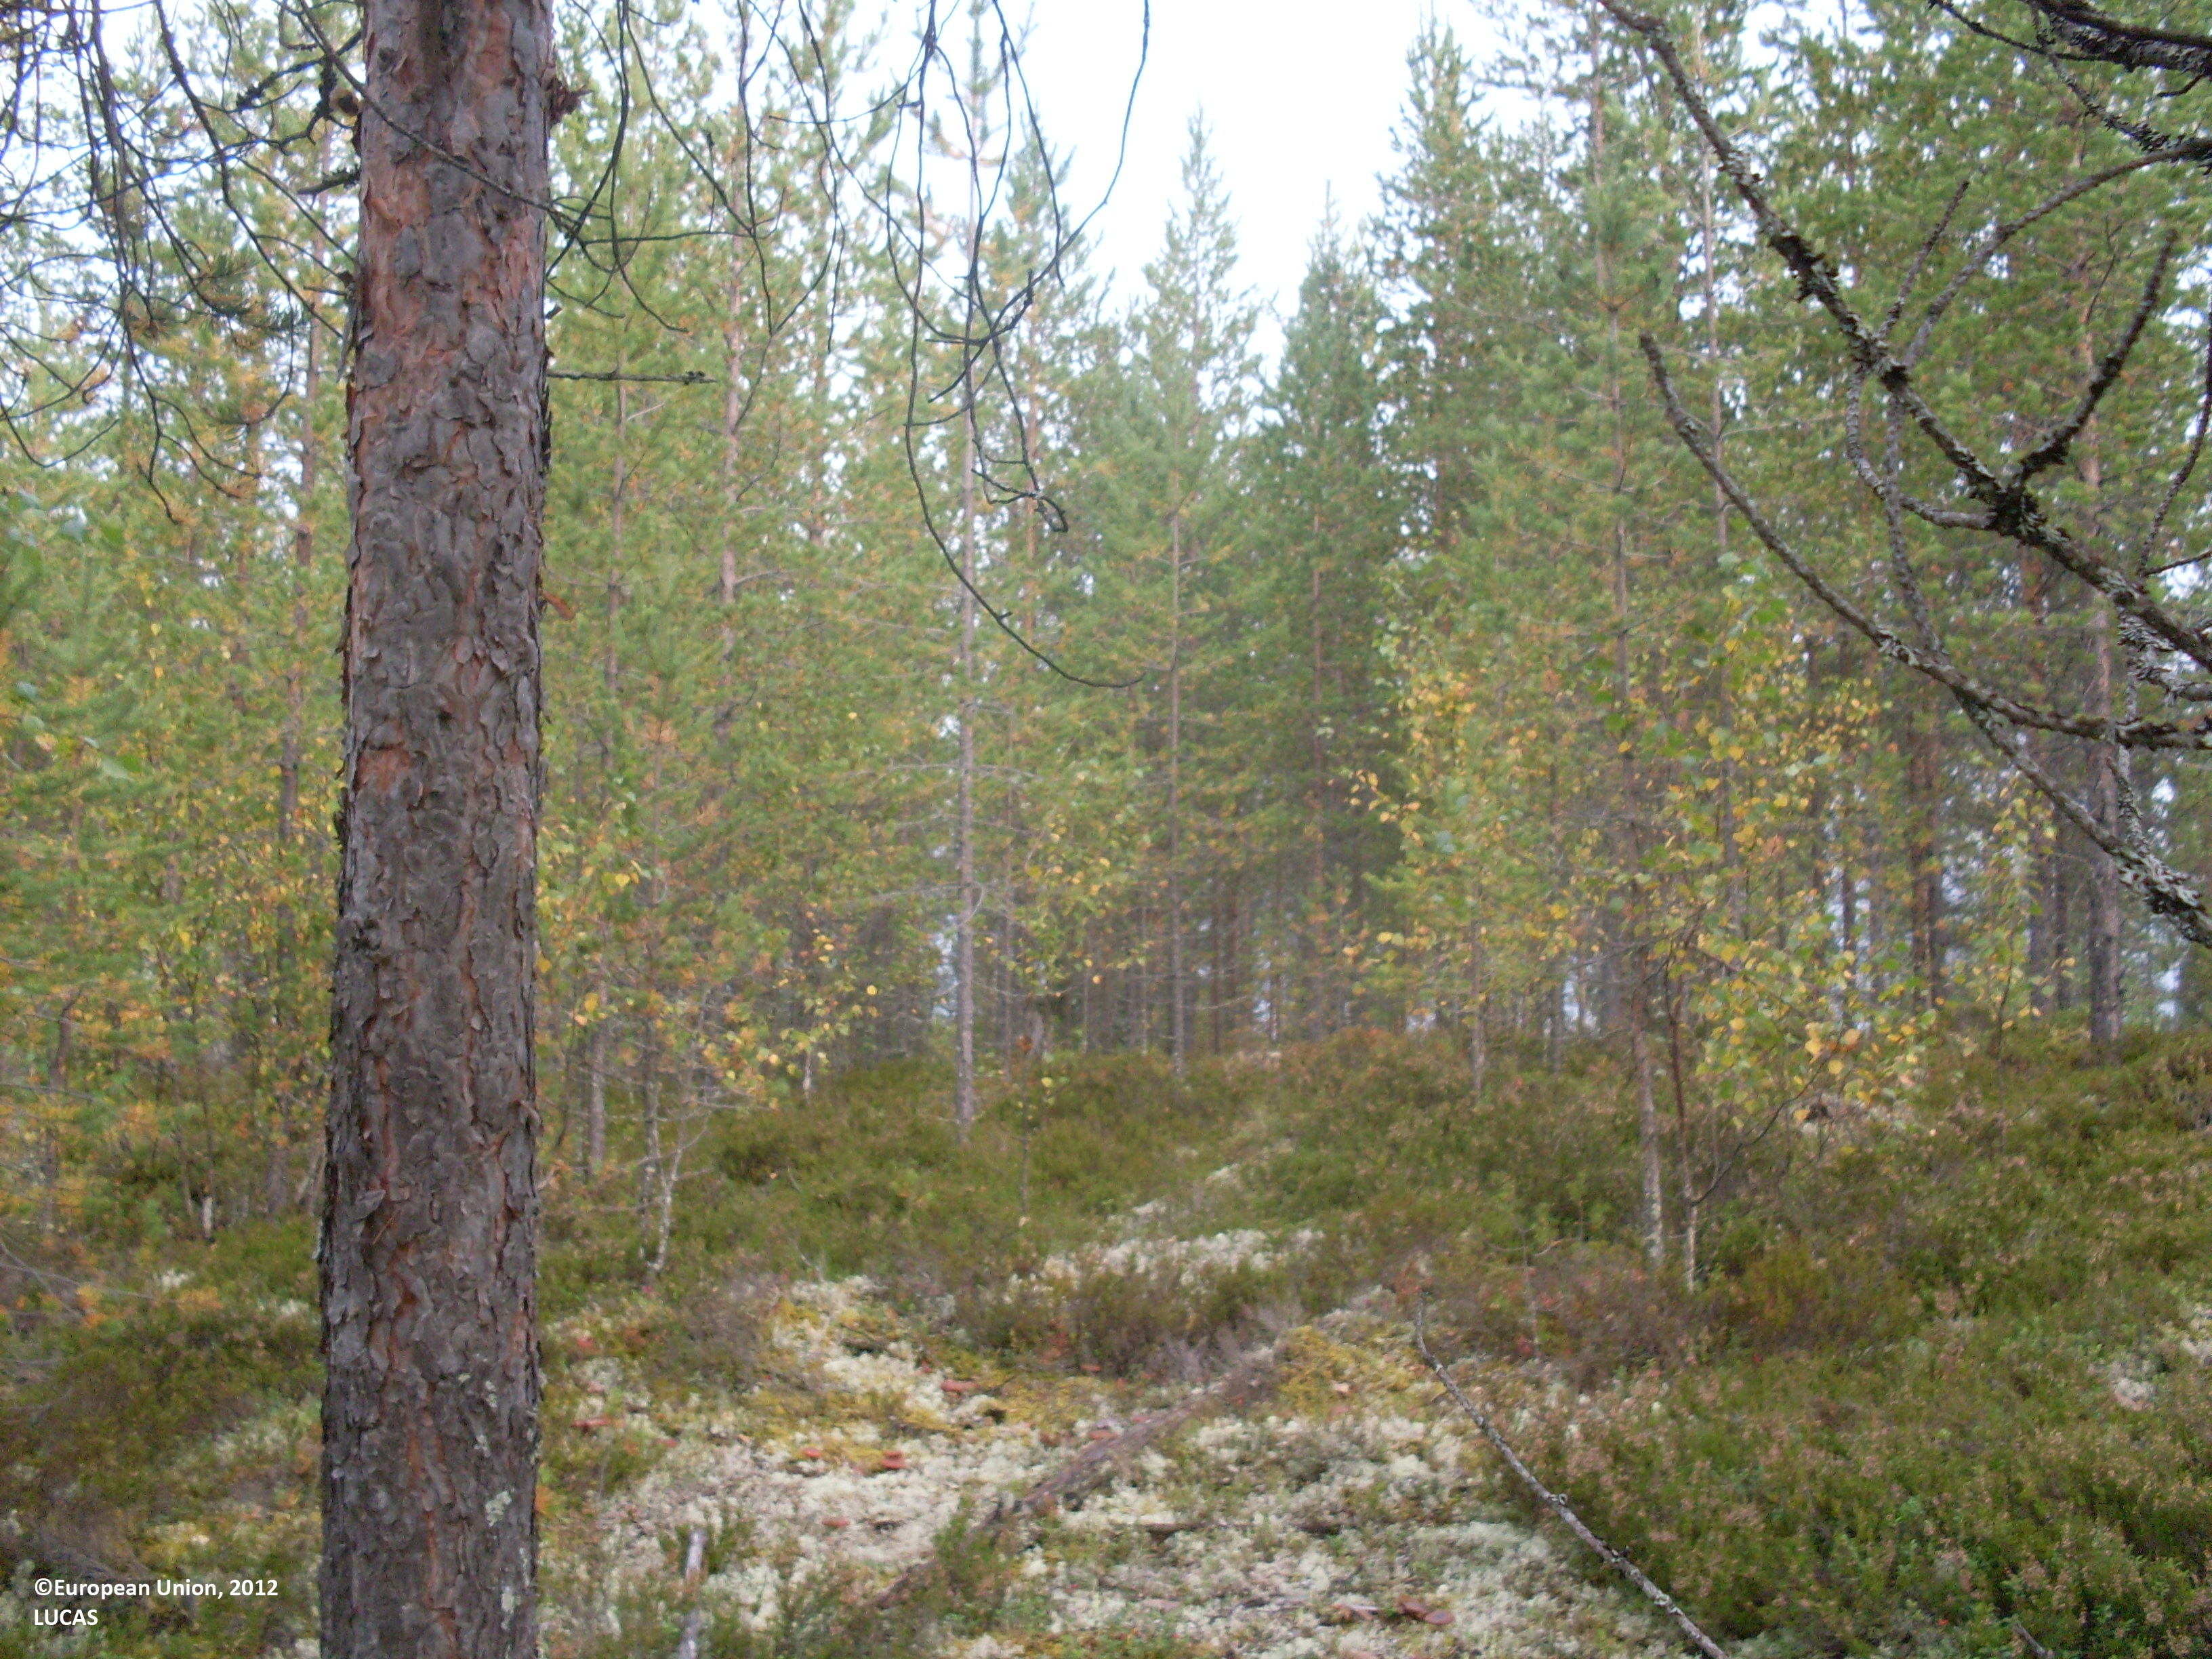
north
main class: Woodland
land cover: Pine dominated coniferous woodland
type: boreal forest
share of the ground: 50 - 75 %
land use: Forestry
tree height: > 5 m
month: September
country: FI
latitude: 64.0789
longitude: 29.5566
